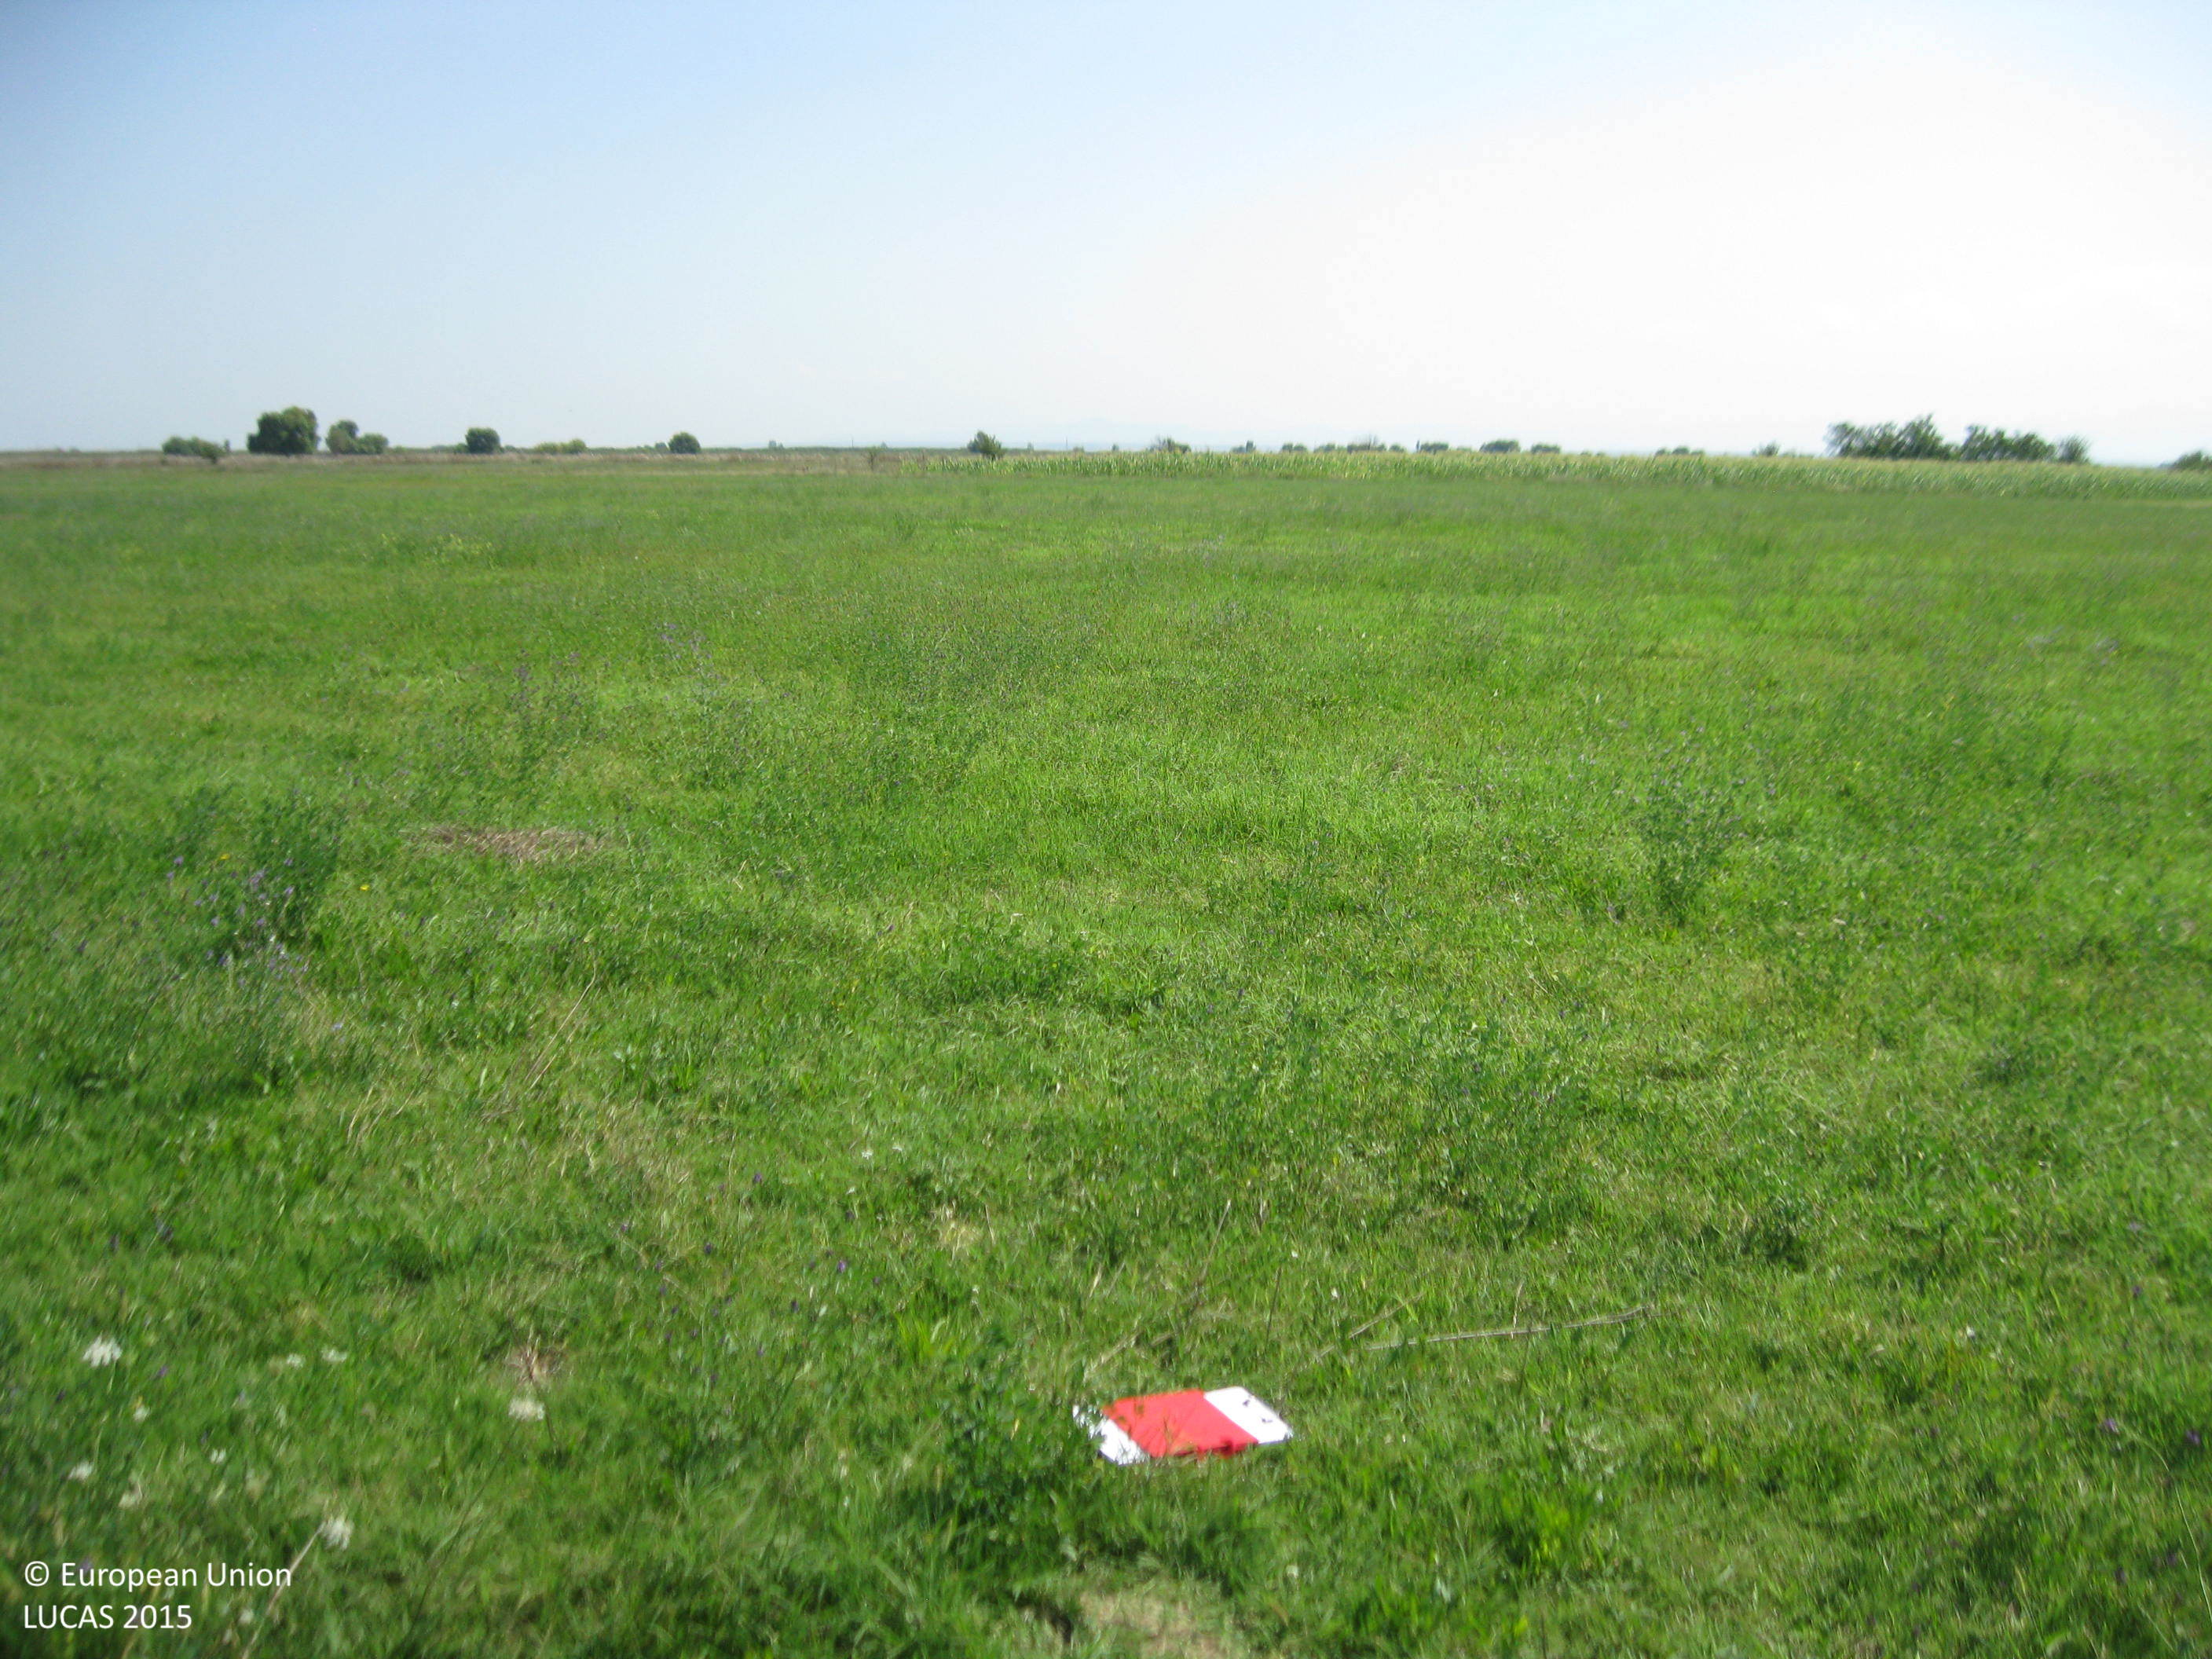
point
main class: Cropland
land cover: Lucerne
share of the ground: > 75 %
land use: Agriculture (excluding fallow land and kitchen gardens)
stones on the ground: < 10 %
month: September
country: BG
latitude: 42.2343
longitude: 24.9484
